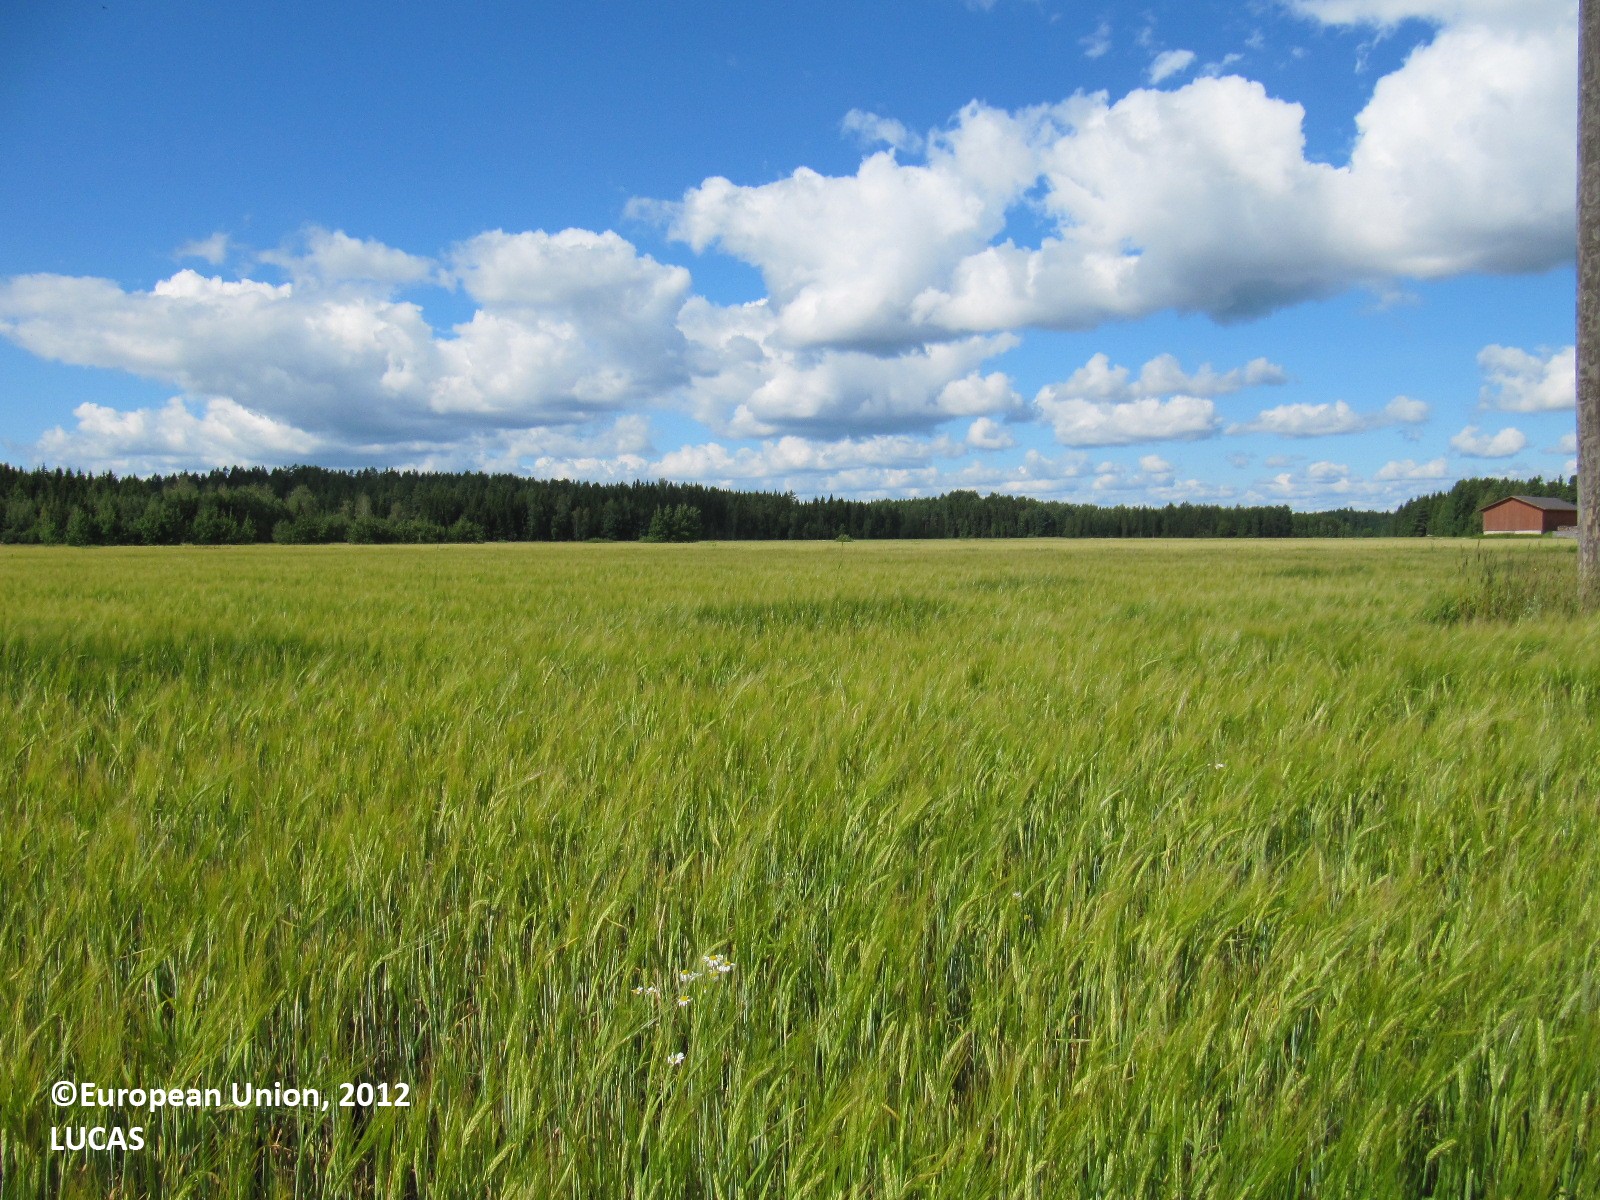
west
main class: Cropland
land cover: Barley
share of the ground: > 75 %
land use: Agriculture (excluding fallow land and kitchen gardens)
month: August
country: FI
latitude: 60.5632
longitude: 23.1962
